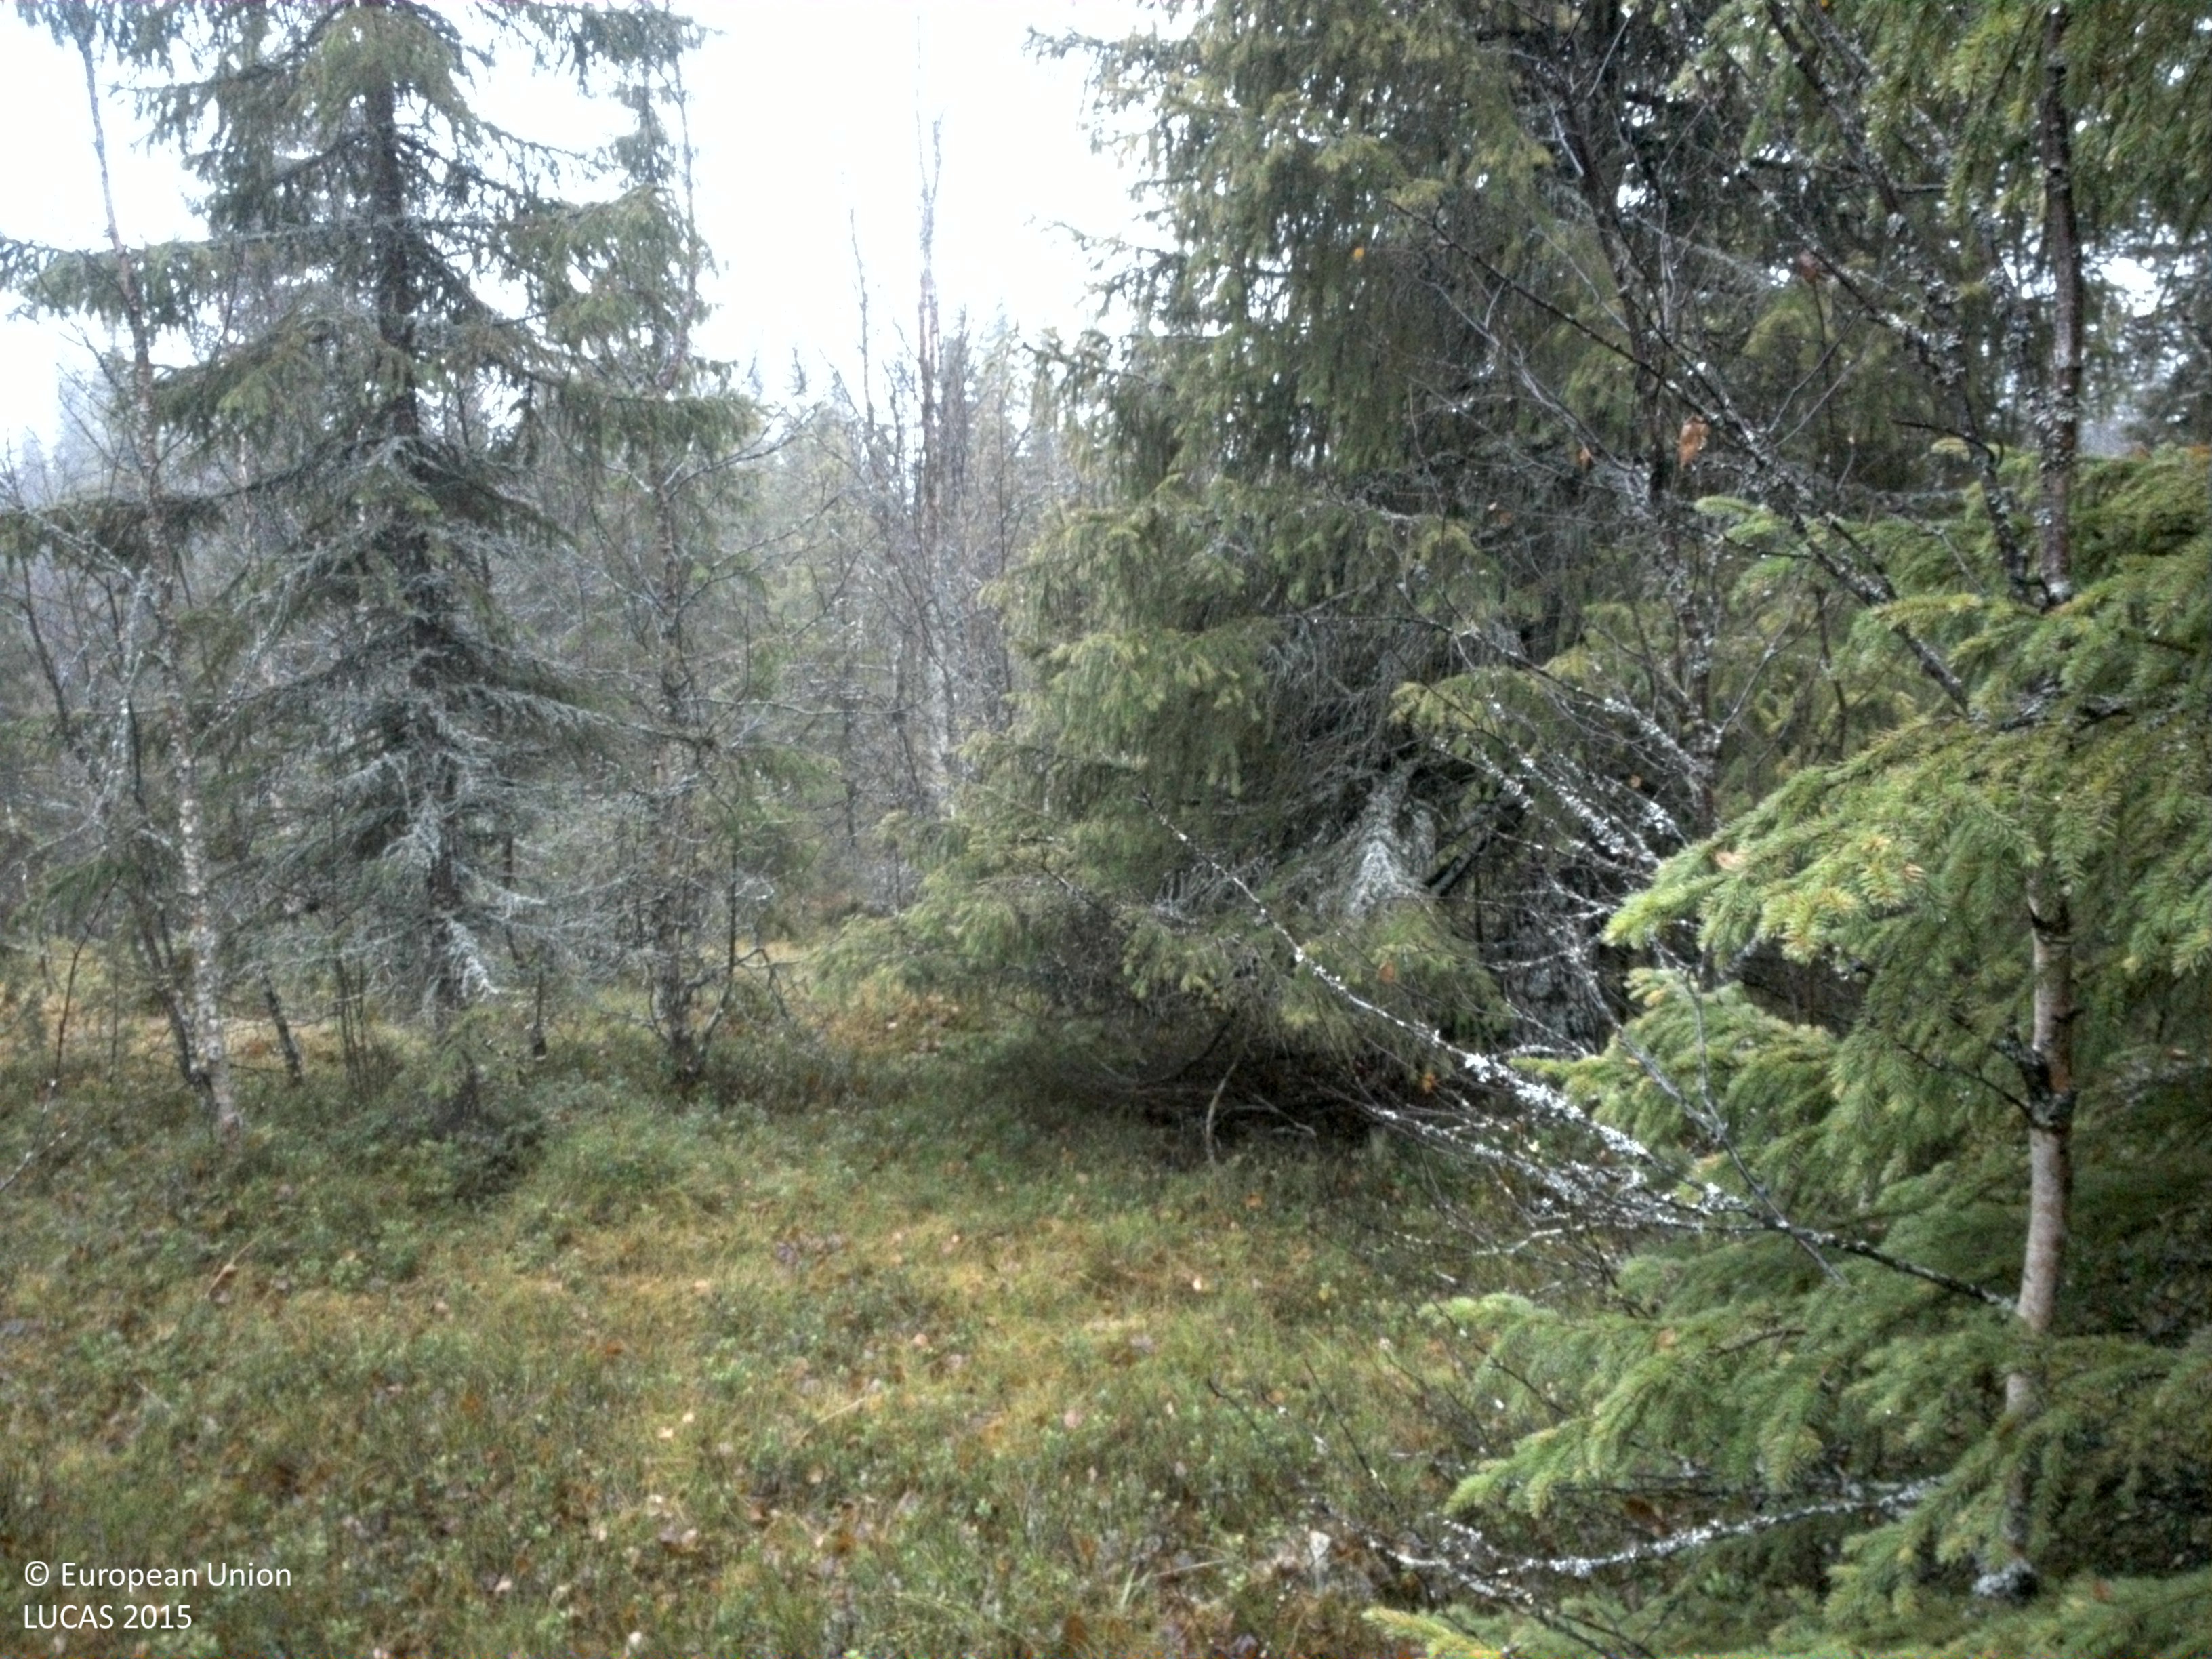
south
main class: Woodland
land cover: Spruce dominated mixed woodland
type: boreal forest
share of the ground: 25 - 50 %
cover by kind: shrubs 40 %, coniferous forest trees 30 %, broadleaved forest trees 15 %, herbaceous plants 10 %, lichens and mosses 5 %
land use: Forestry
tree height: > 5 m
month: October
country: SE
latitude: 64.5118
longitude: 17.4858
